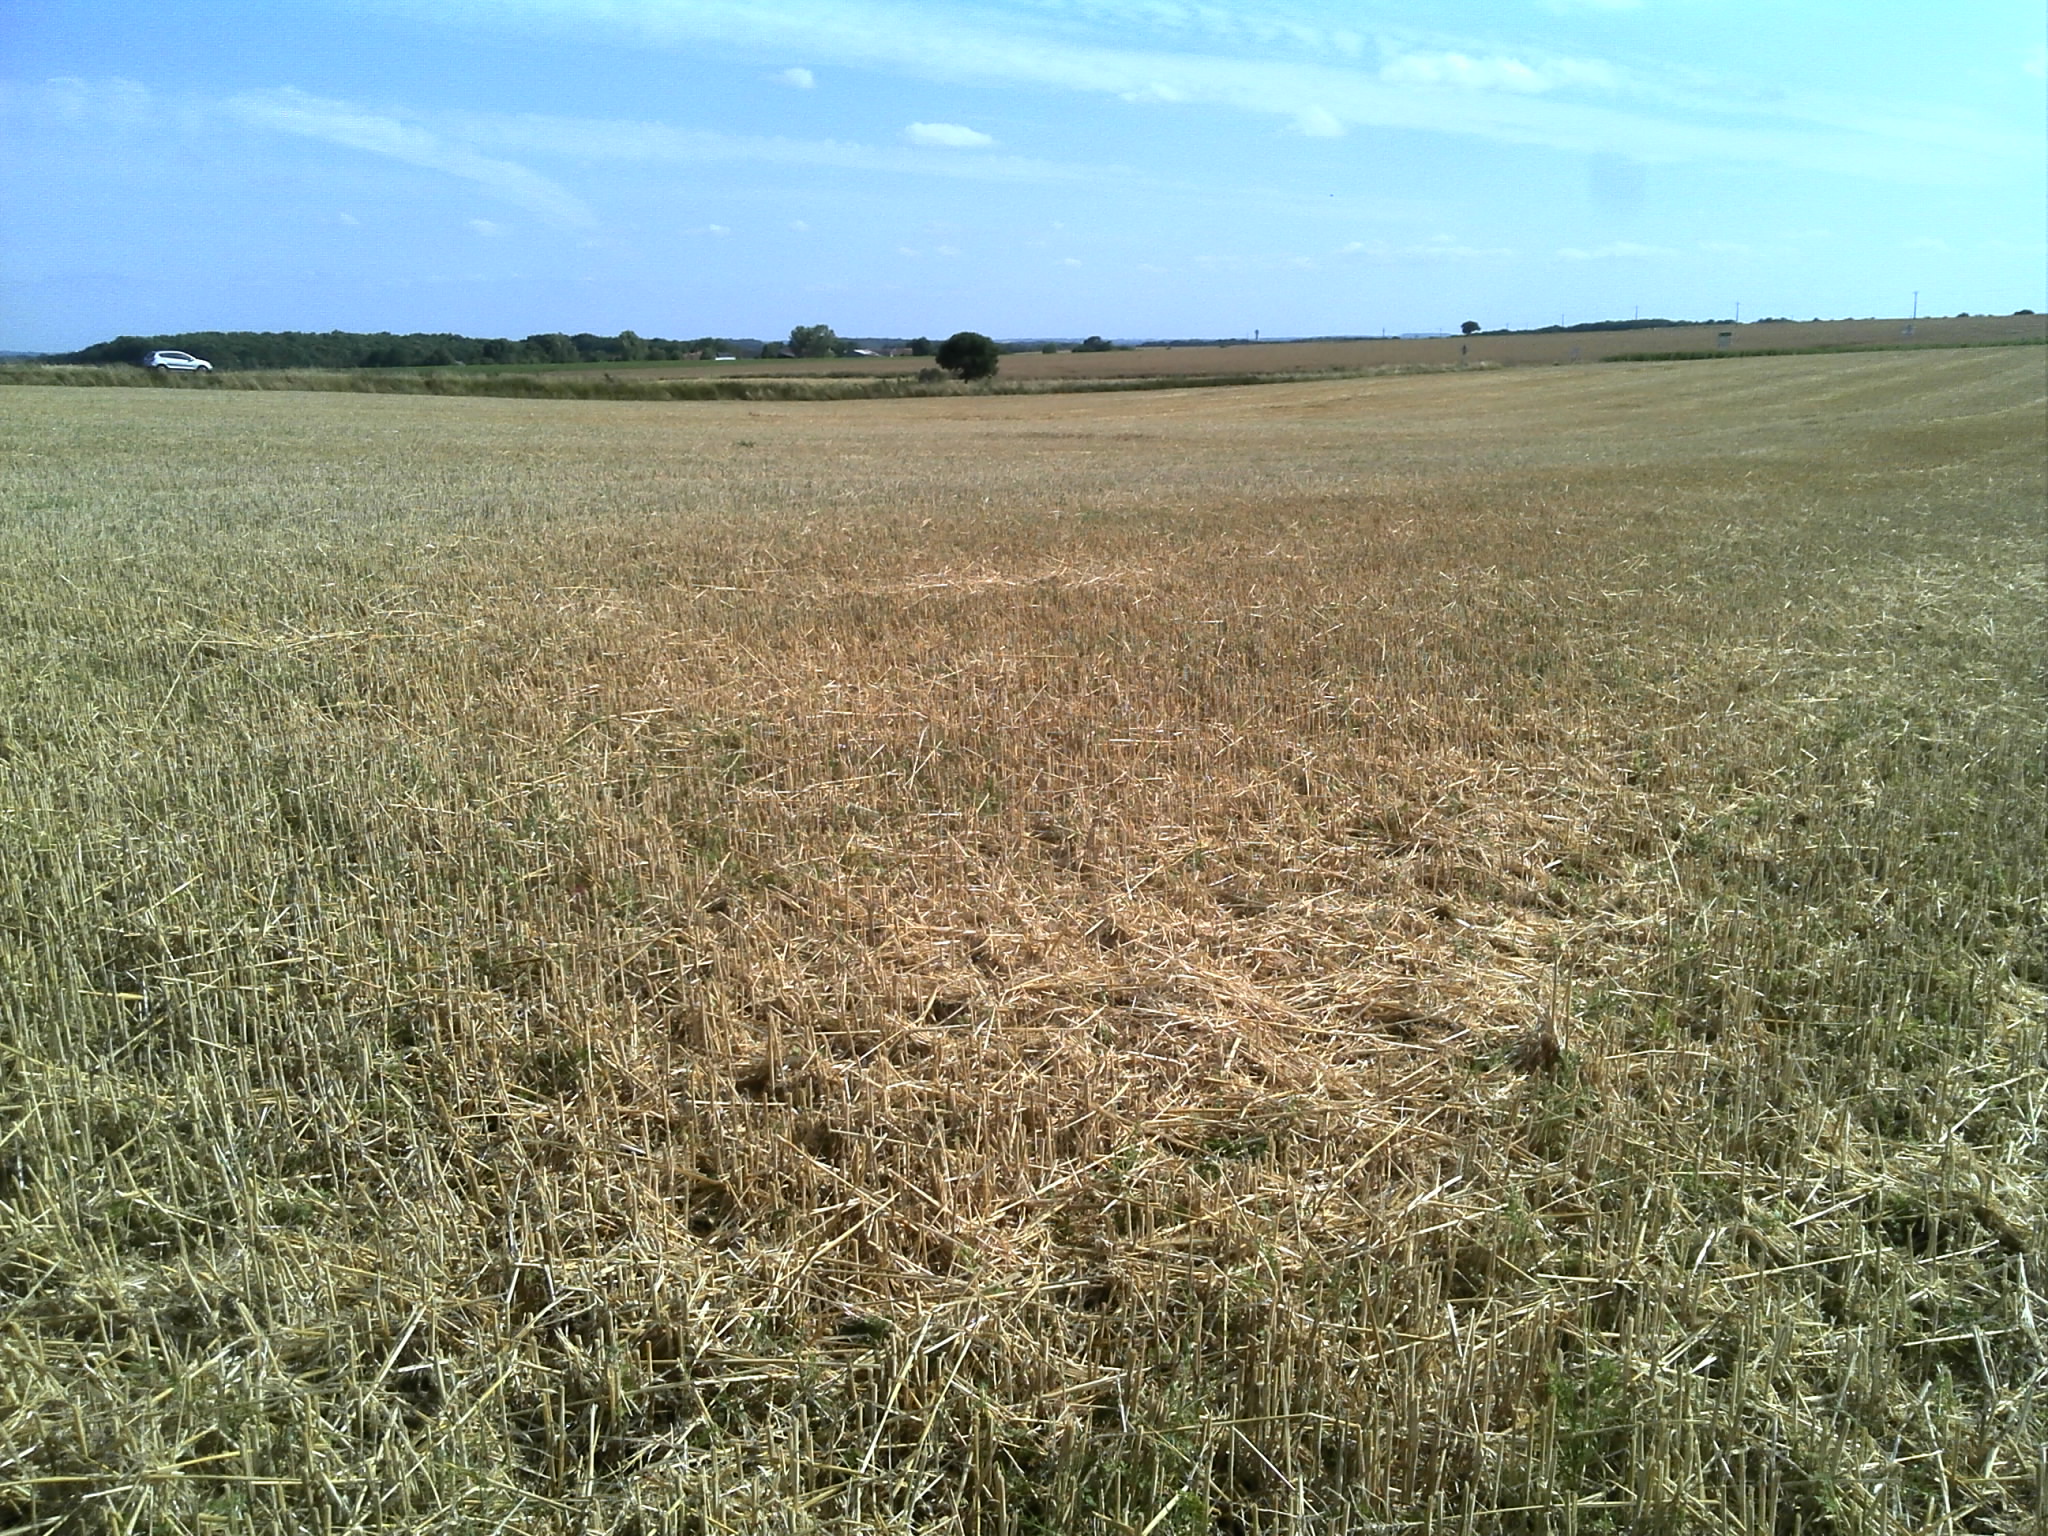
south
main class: Cropland
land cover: Common wheat
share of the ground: > 75 %
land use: Agriculture (excluding fallow land and kitchen gardens)
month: July
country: FR
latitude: 46.6826
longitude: 1.5040
